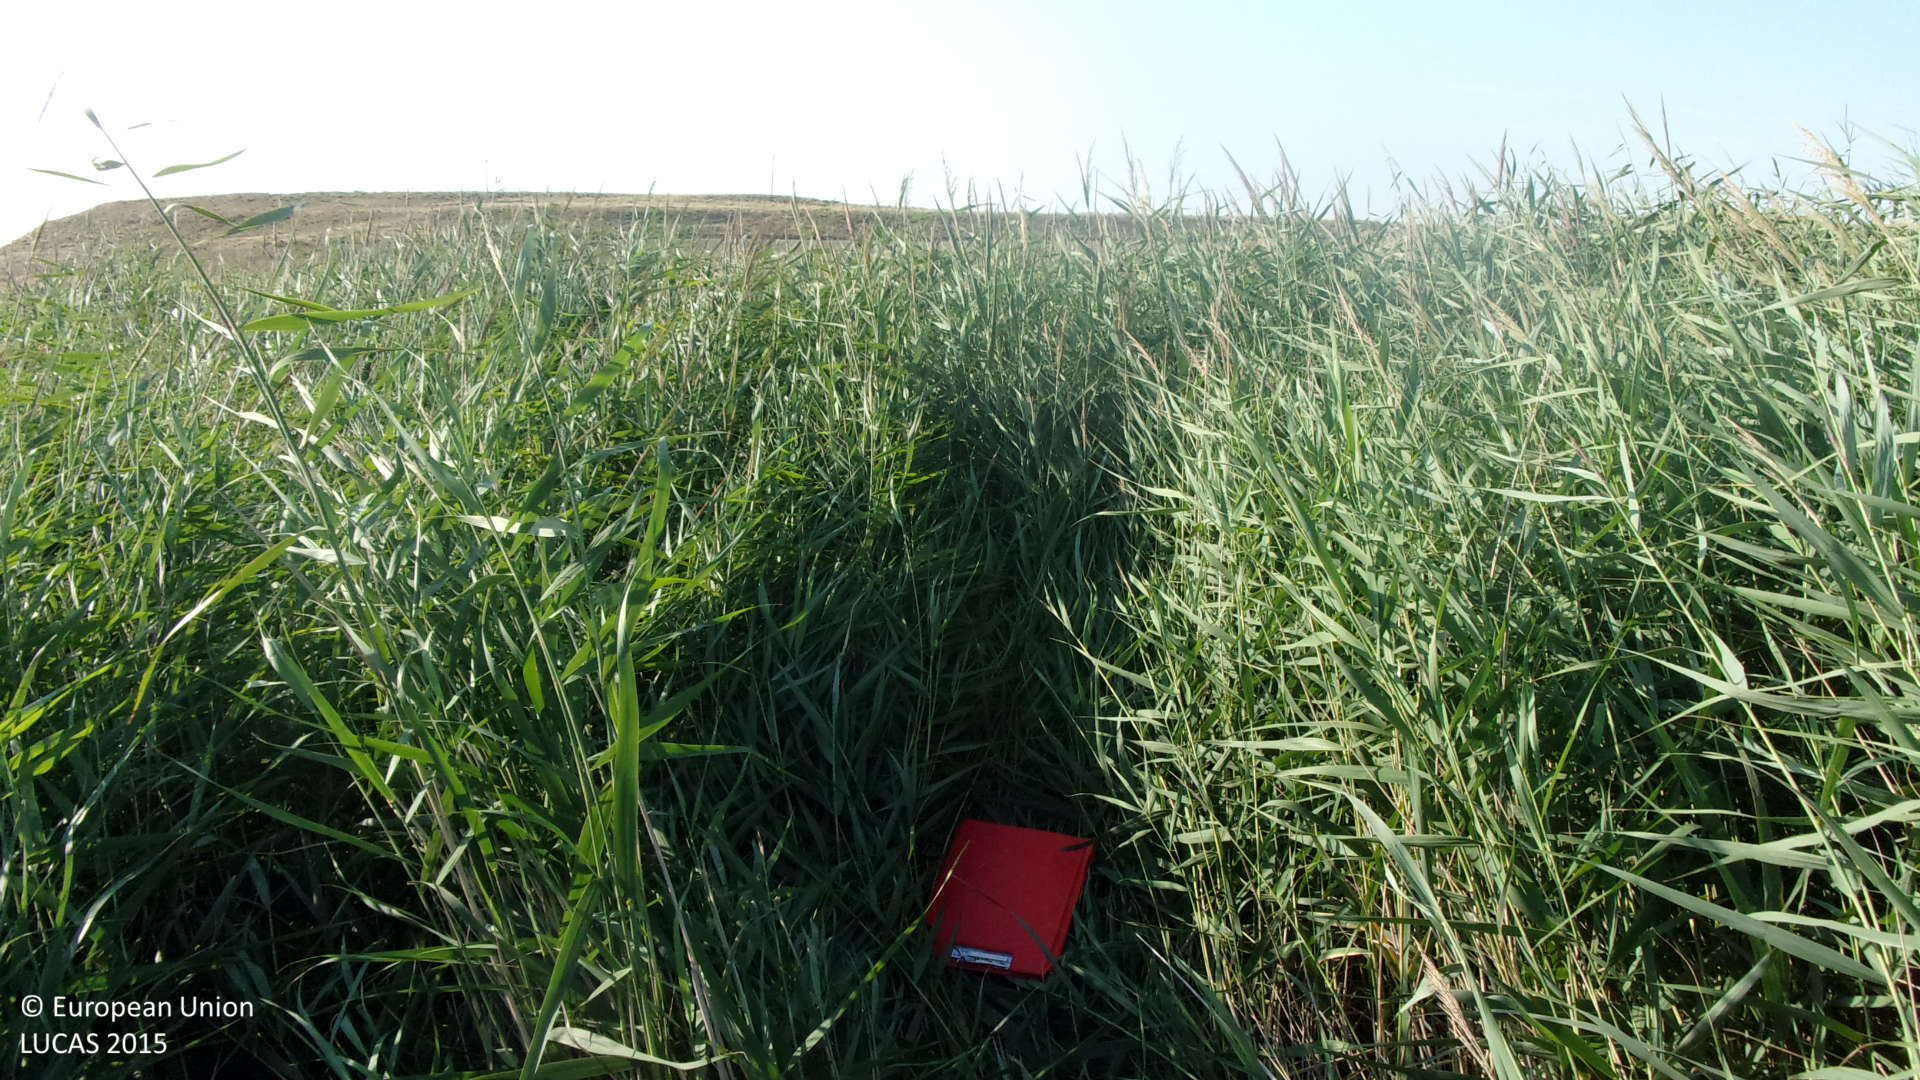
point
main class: Shrubland
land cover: Shrubland without tree cover
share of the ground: > 75 %
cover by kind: shrubs 100 %
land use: Semi-natural and natural areas not in use
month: July
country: ES
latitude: 41.8350
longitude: -1.4802
